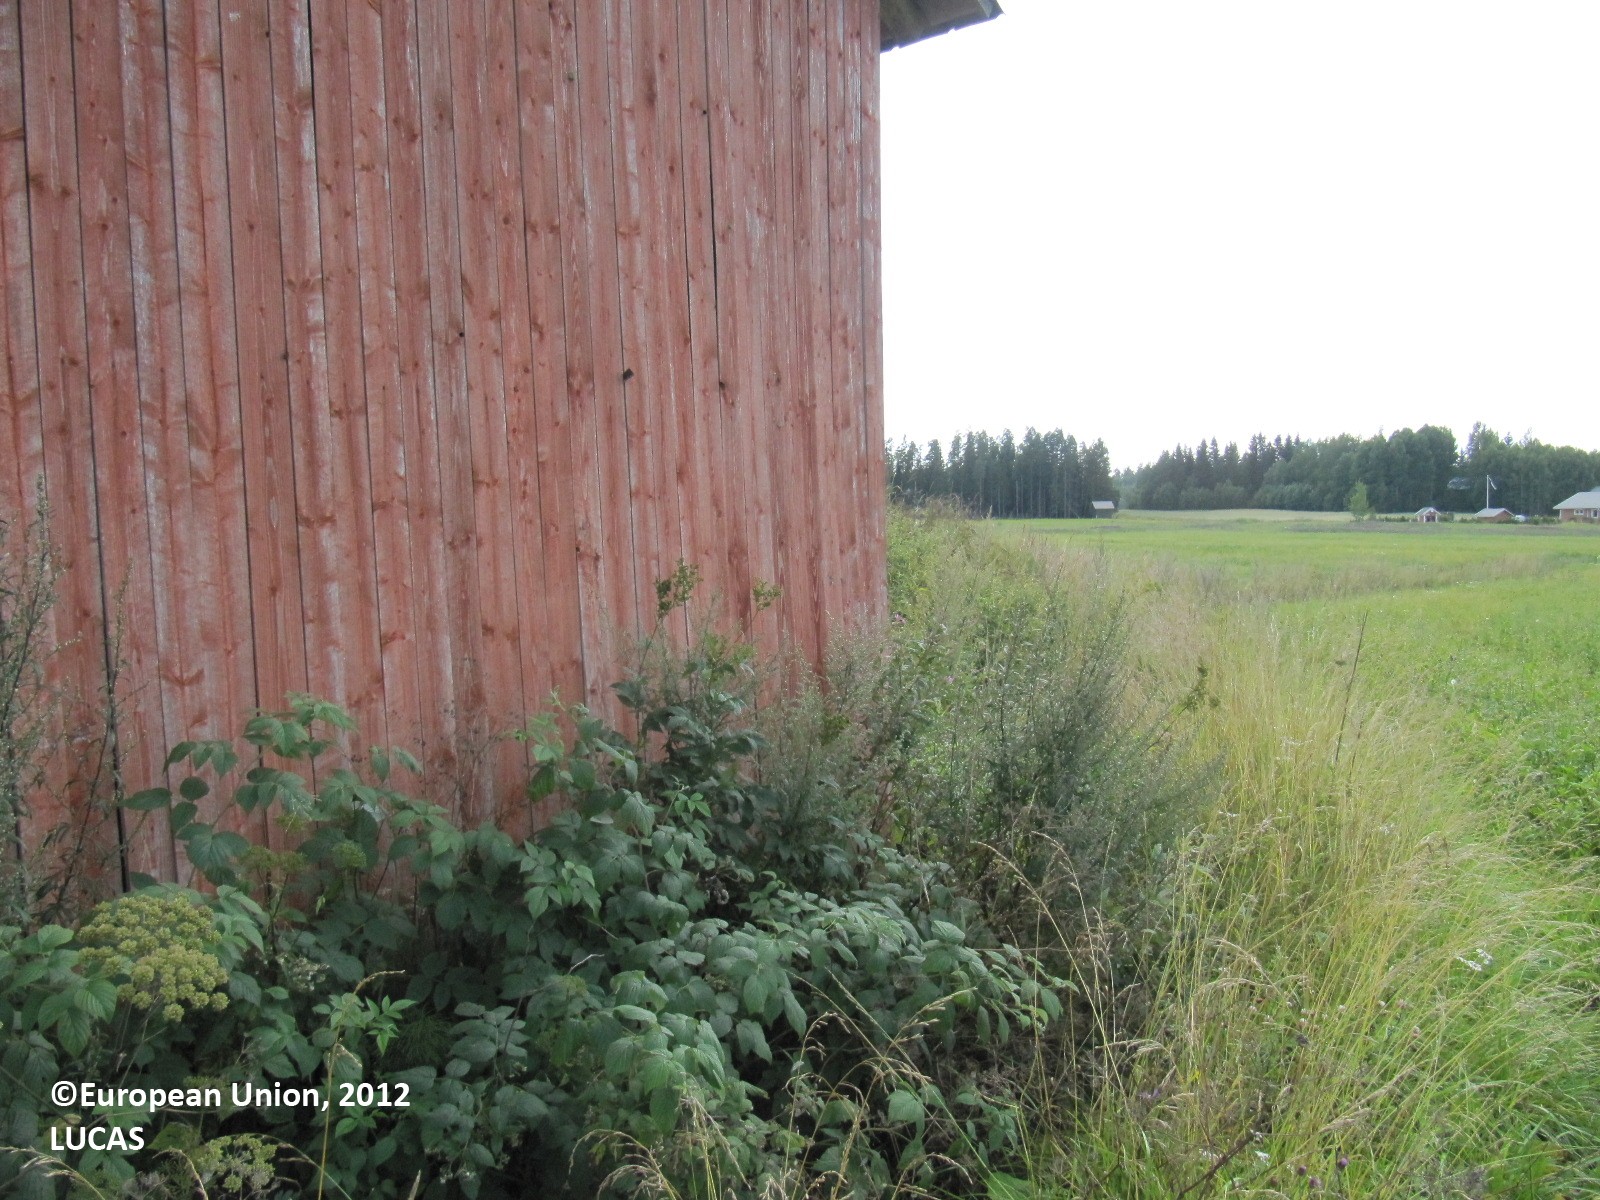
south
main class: Cropland
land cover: Dry pulses
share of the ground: > 75 %
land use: Agriculture (excluding fallow land and kitchen gardens)
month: August
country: FI
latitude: 60.3919
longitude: 24.3849
